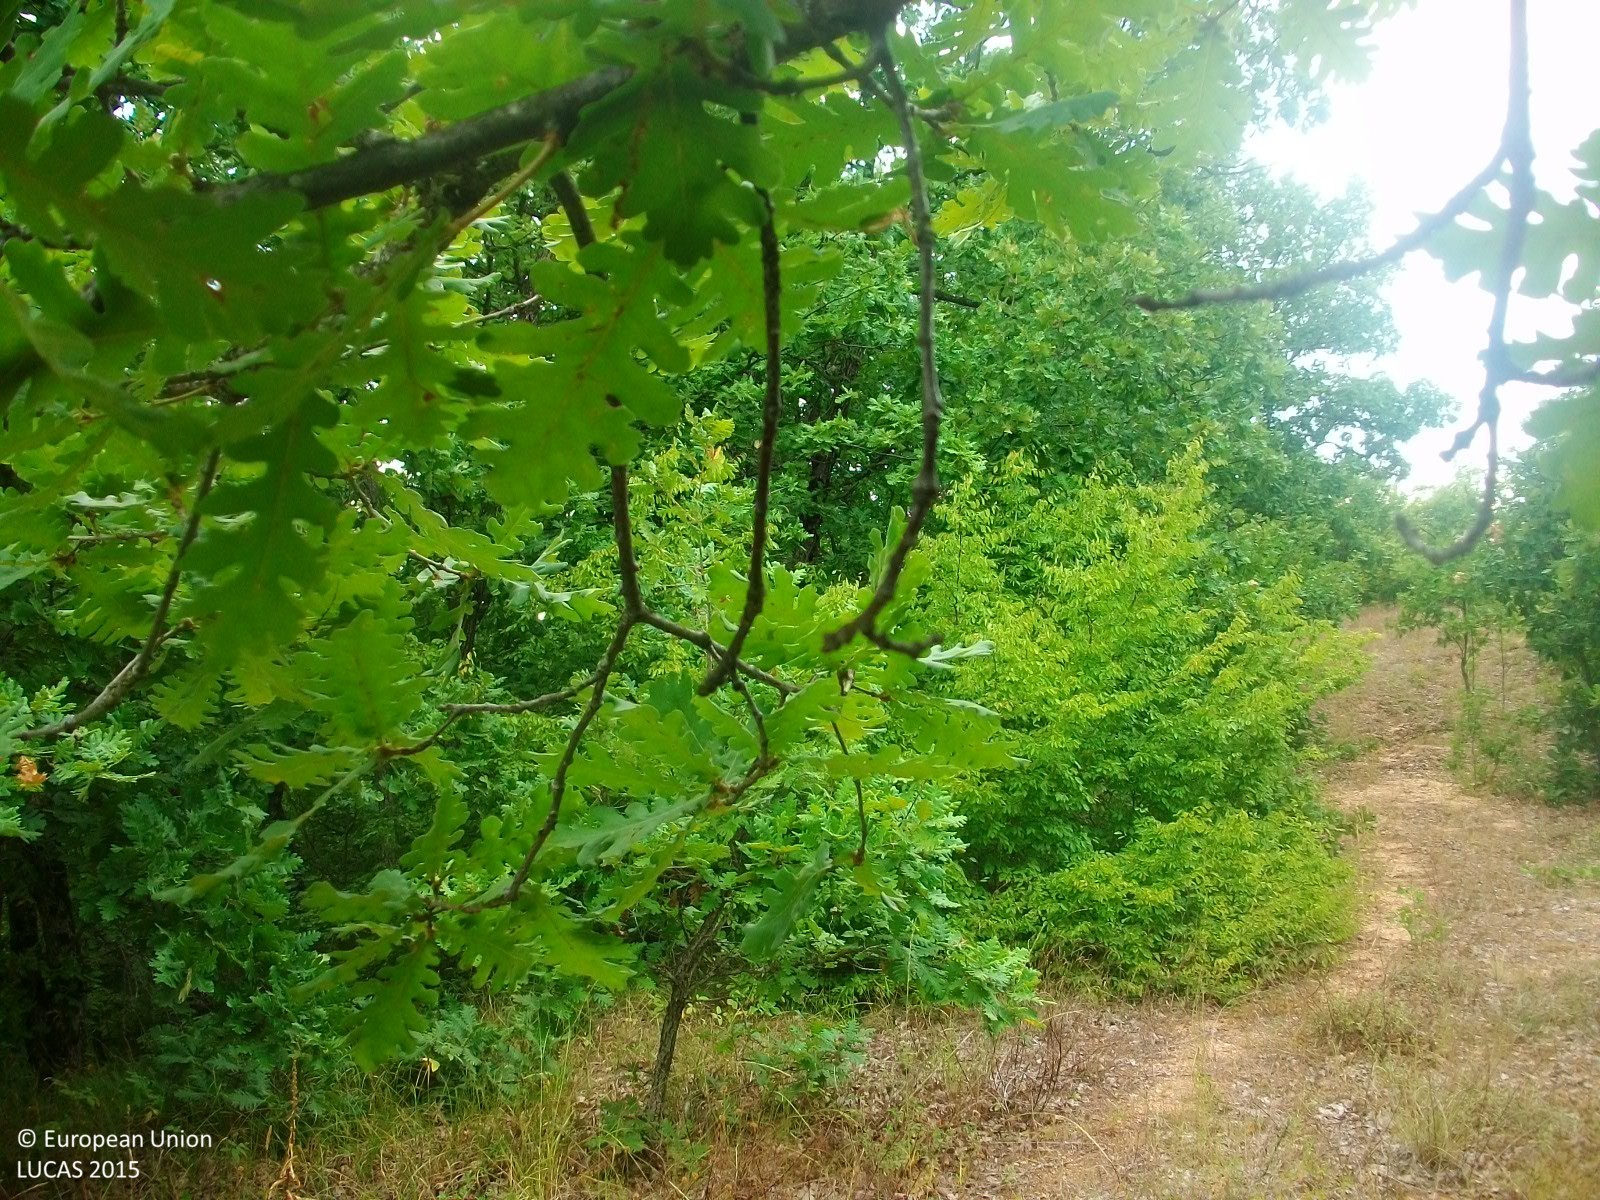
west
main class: Woodland
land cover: Broadleaved woodland
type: thermophilous deciduous forest
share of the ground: > 75 %
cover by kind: broadleaved forest trees 90 %, herbaceous plants 10 %
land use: Forestry
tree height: > 5 m
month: August
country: GR
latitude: 41.3374
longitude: 26.2140
